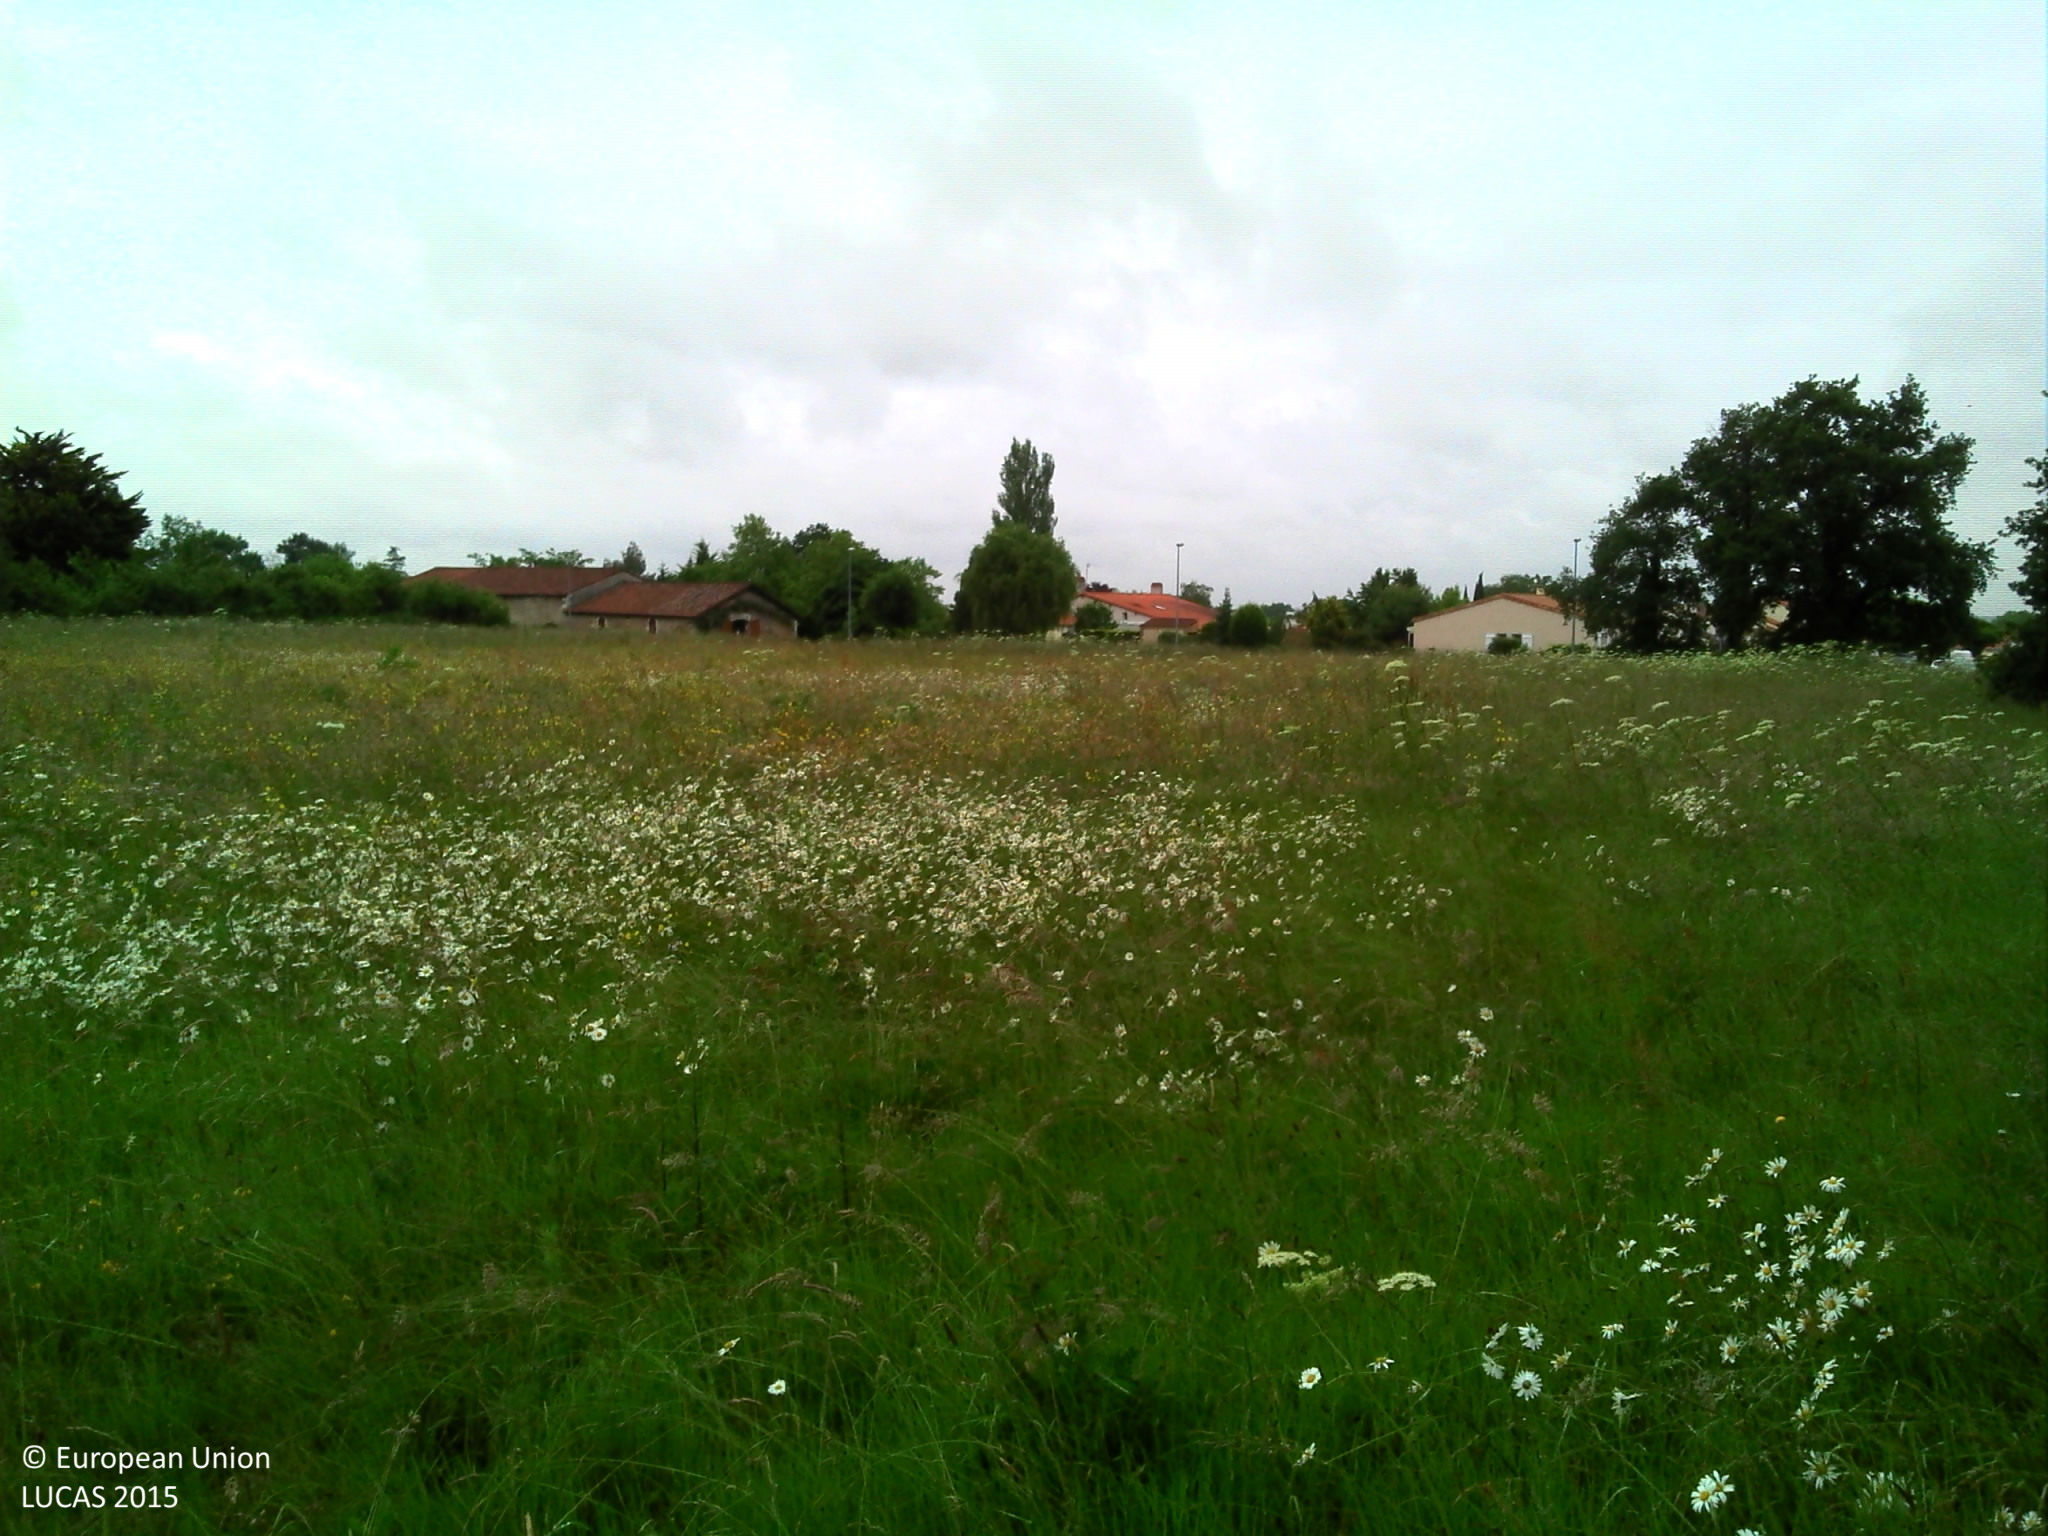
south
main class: Grassland
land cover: Grassland without tree/shrub cover
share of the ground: > 75 %
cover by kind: herbaceous plants 100 %
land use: Agriculture (excluding fallow land and kitchen gardens)
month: June
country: FR
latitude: 47.1716
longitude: -1.2658
